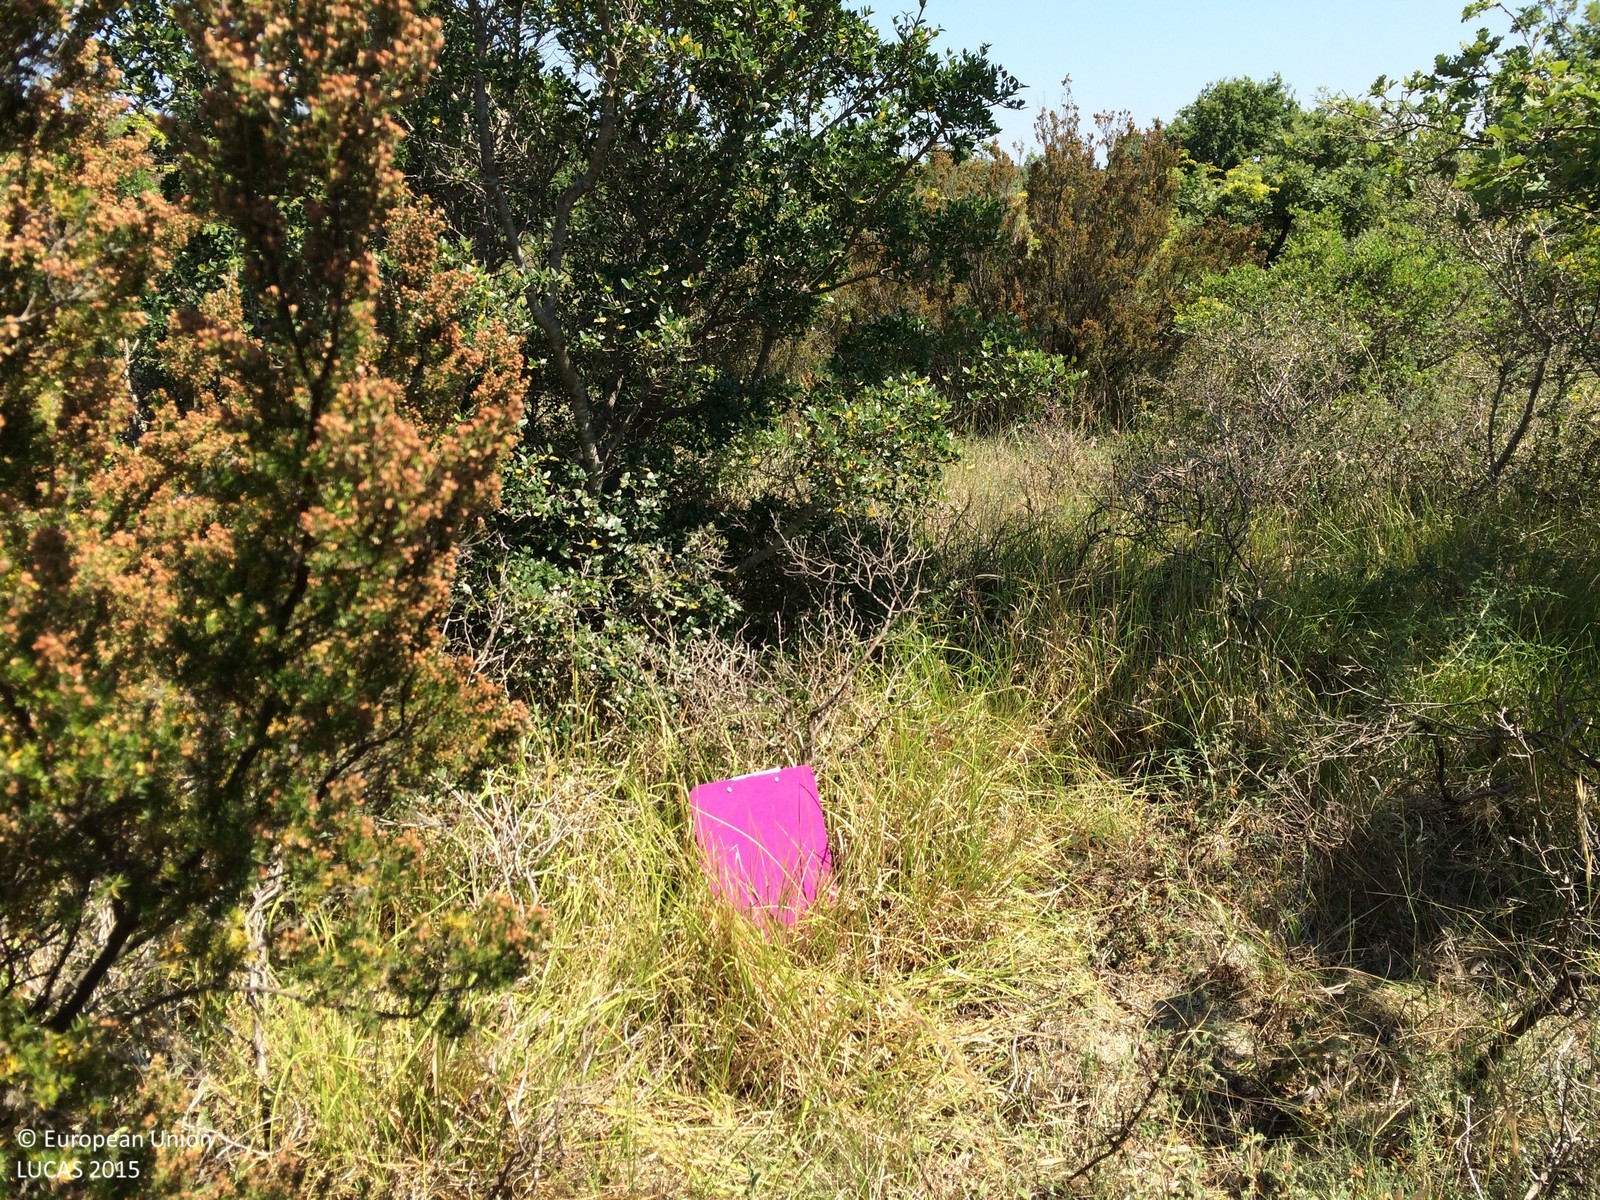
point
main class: Shrubland
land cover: Shrubland with sparse tree cover
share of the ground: > 75 %
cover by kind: shrubs 90 %, broadleaved forest trees 5 %, herbaceous plants 5 %
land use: Semi-natural and natural areas not in use
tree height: < 5 m
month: June
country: HR
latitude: 45.0025
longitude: 13.8130
